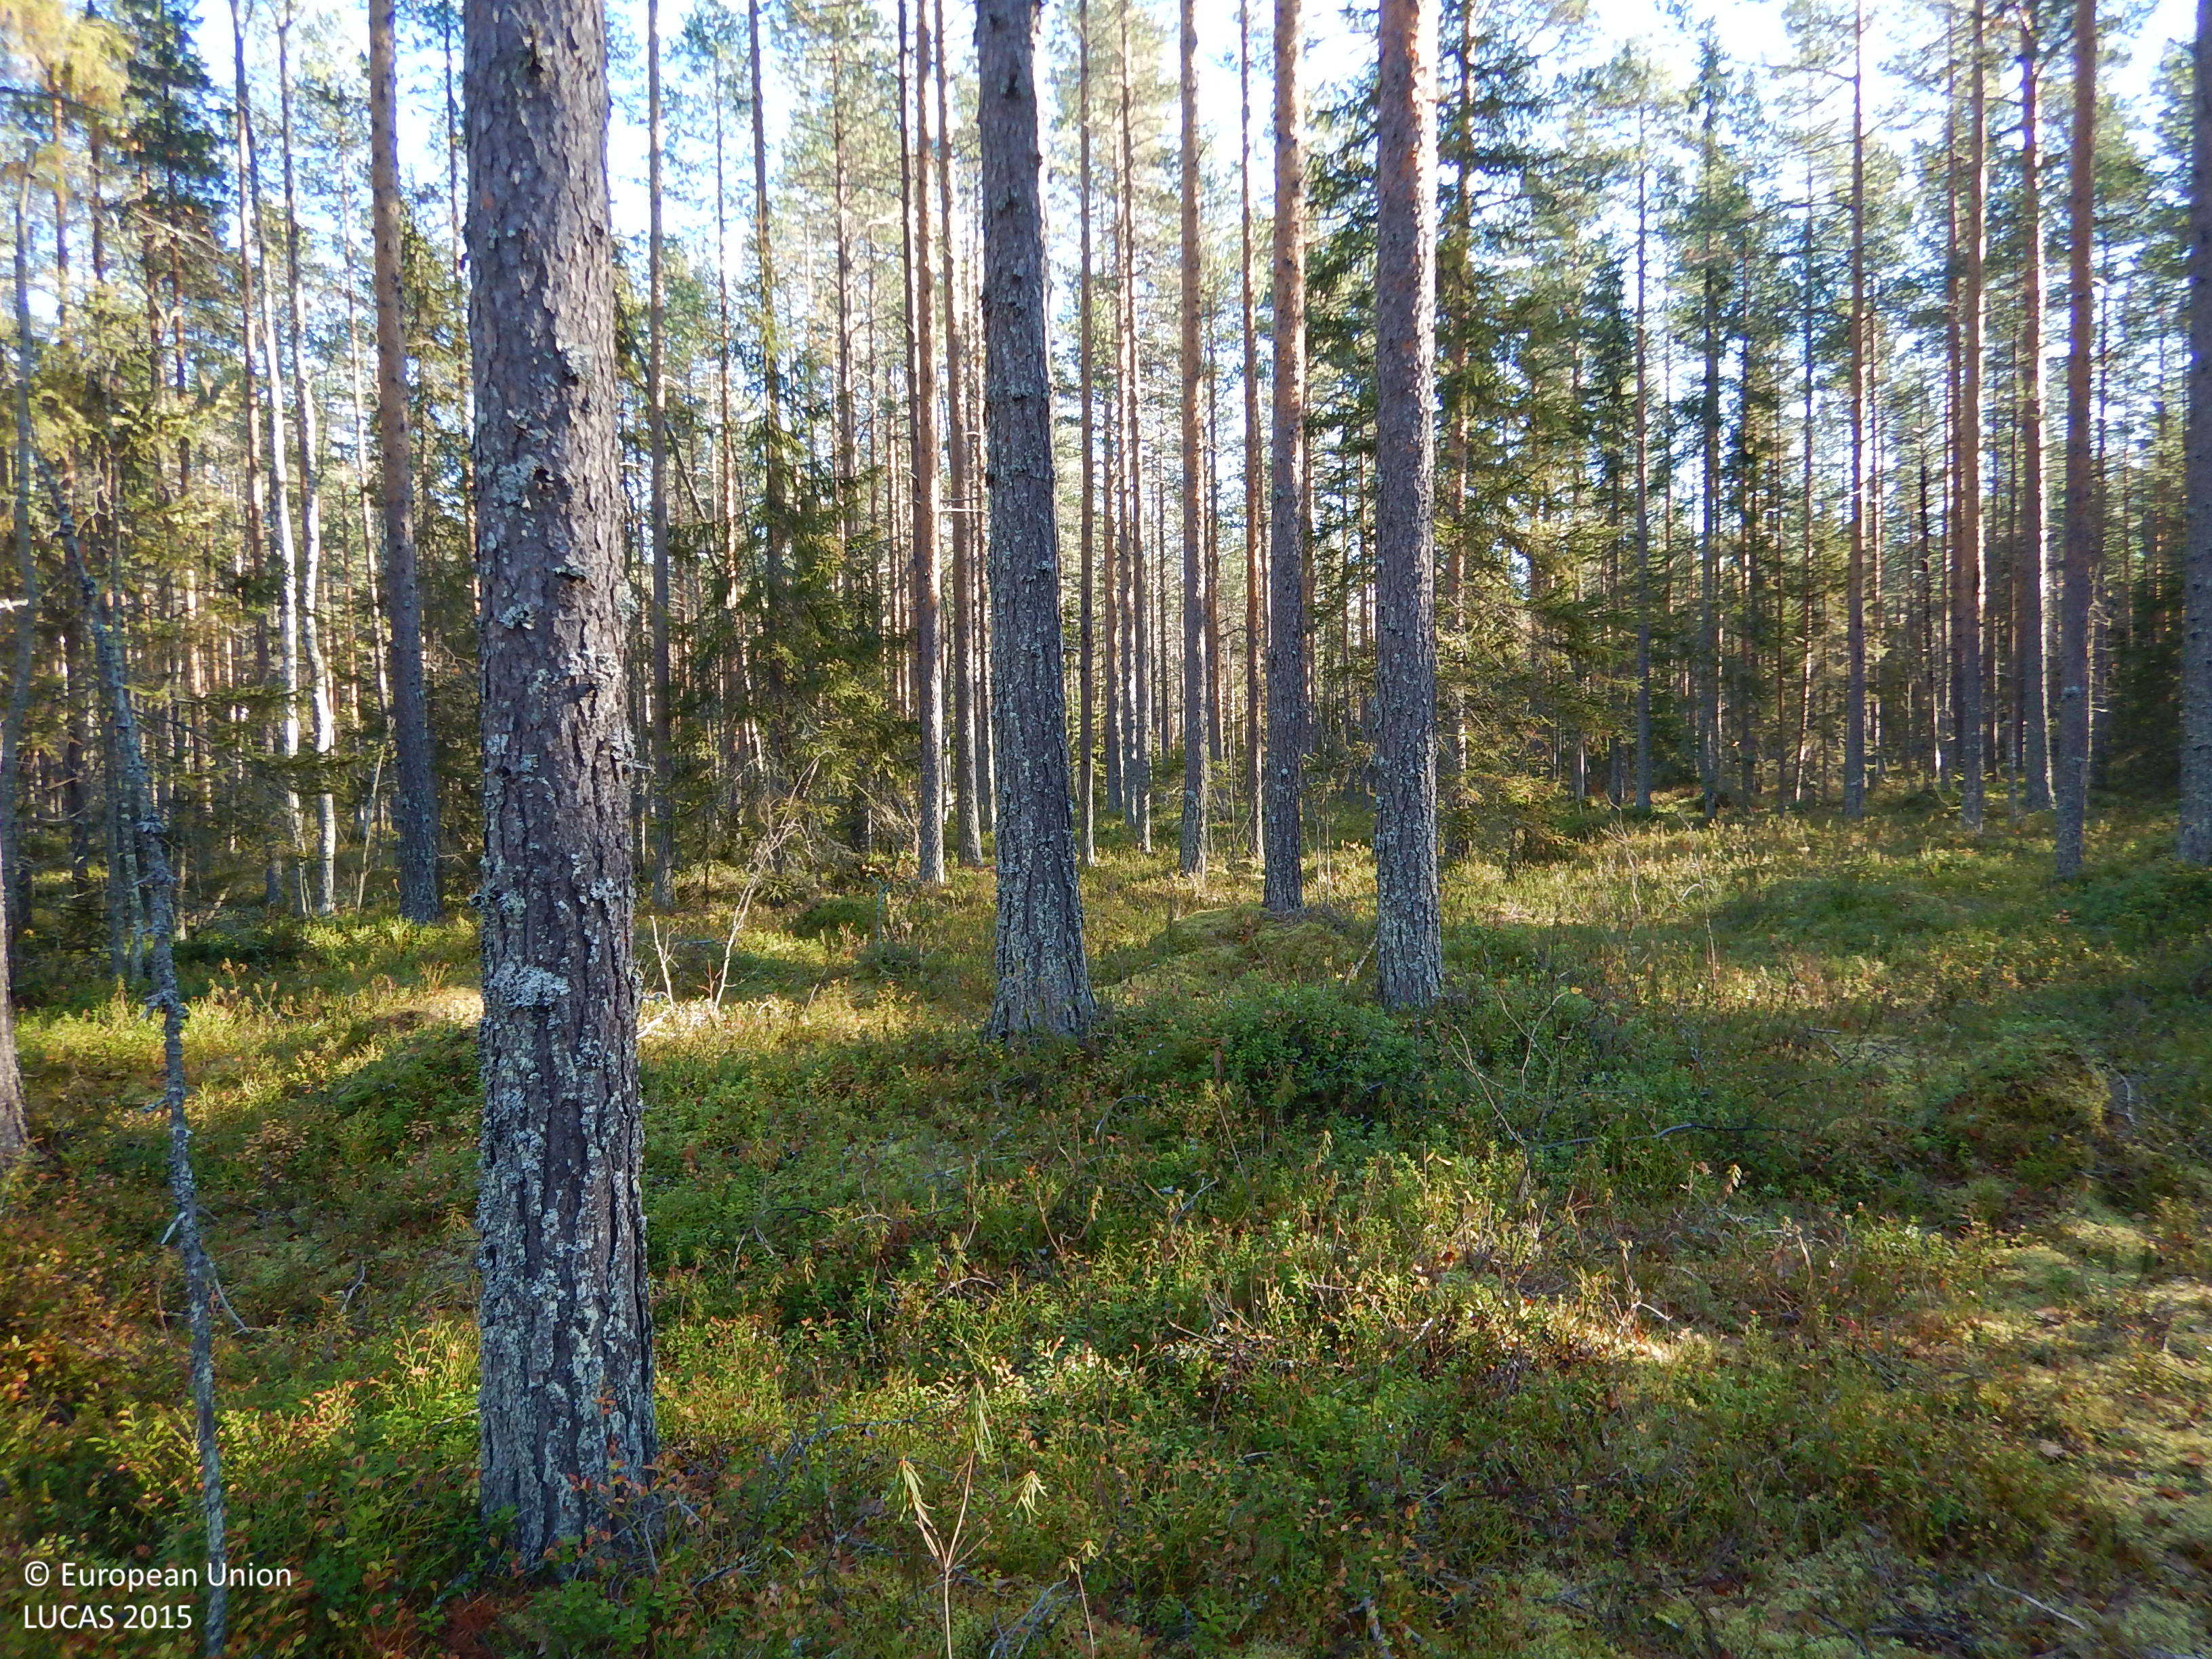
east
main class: Woodland
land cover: Pine dominated coniferous woodland
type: boreal forest
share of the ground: 50 - 75 %
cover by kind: coniferous forest trees 60 %, shrubs 15 %, lichens and mosses 15 %, broadleaved forest trees 5 %, herbaceous plants 5 %
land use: Forestry
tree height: > 5 m
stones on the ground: < 10 %
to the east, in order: Pine dominated coniferous woodland; Pine dominated mixed woodland; Ditches and canals; Pine dominated mixed woodland; Other coniferous woodland
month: October
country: SE
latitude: 65.0476
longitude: 21.1296
